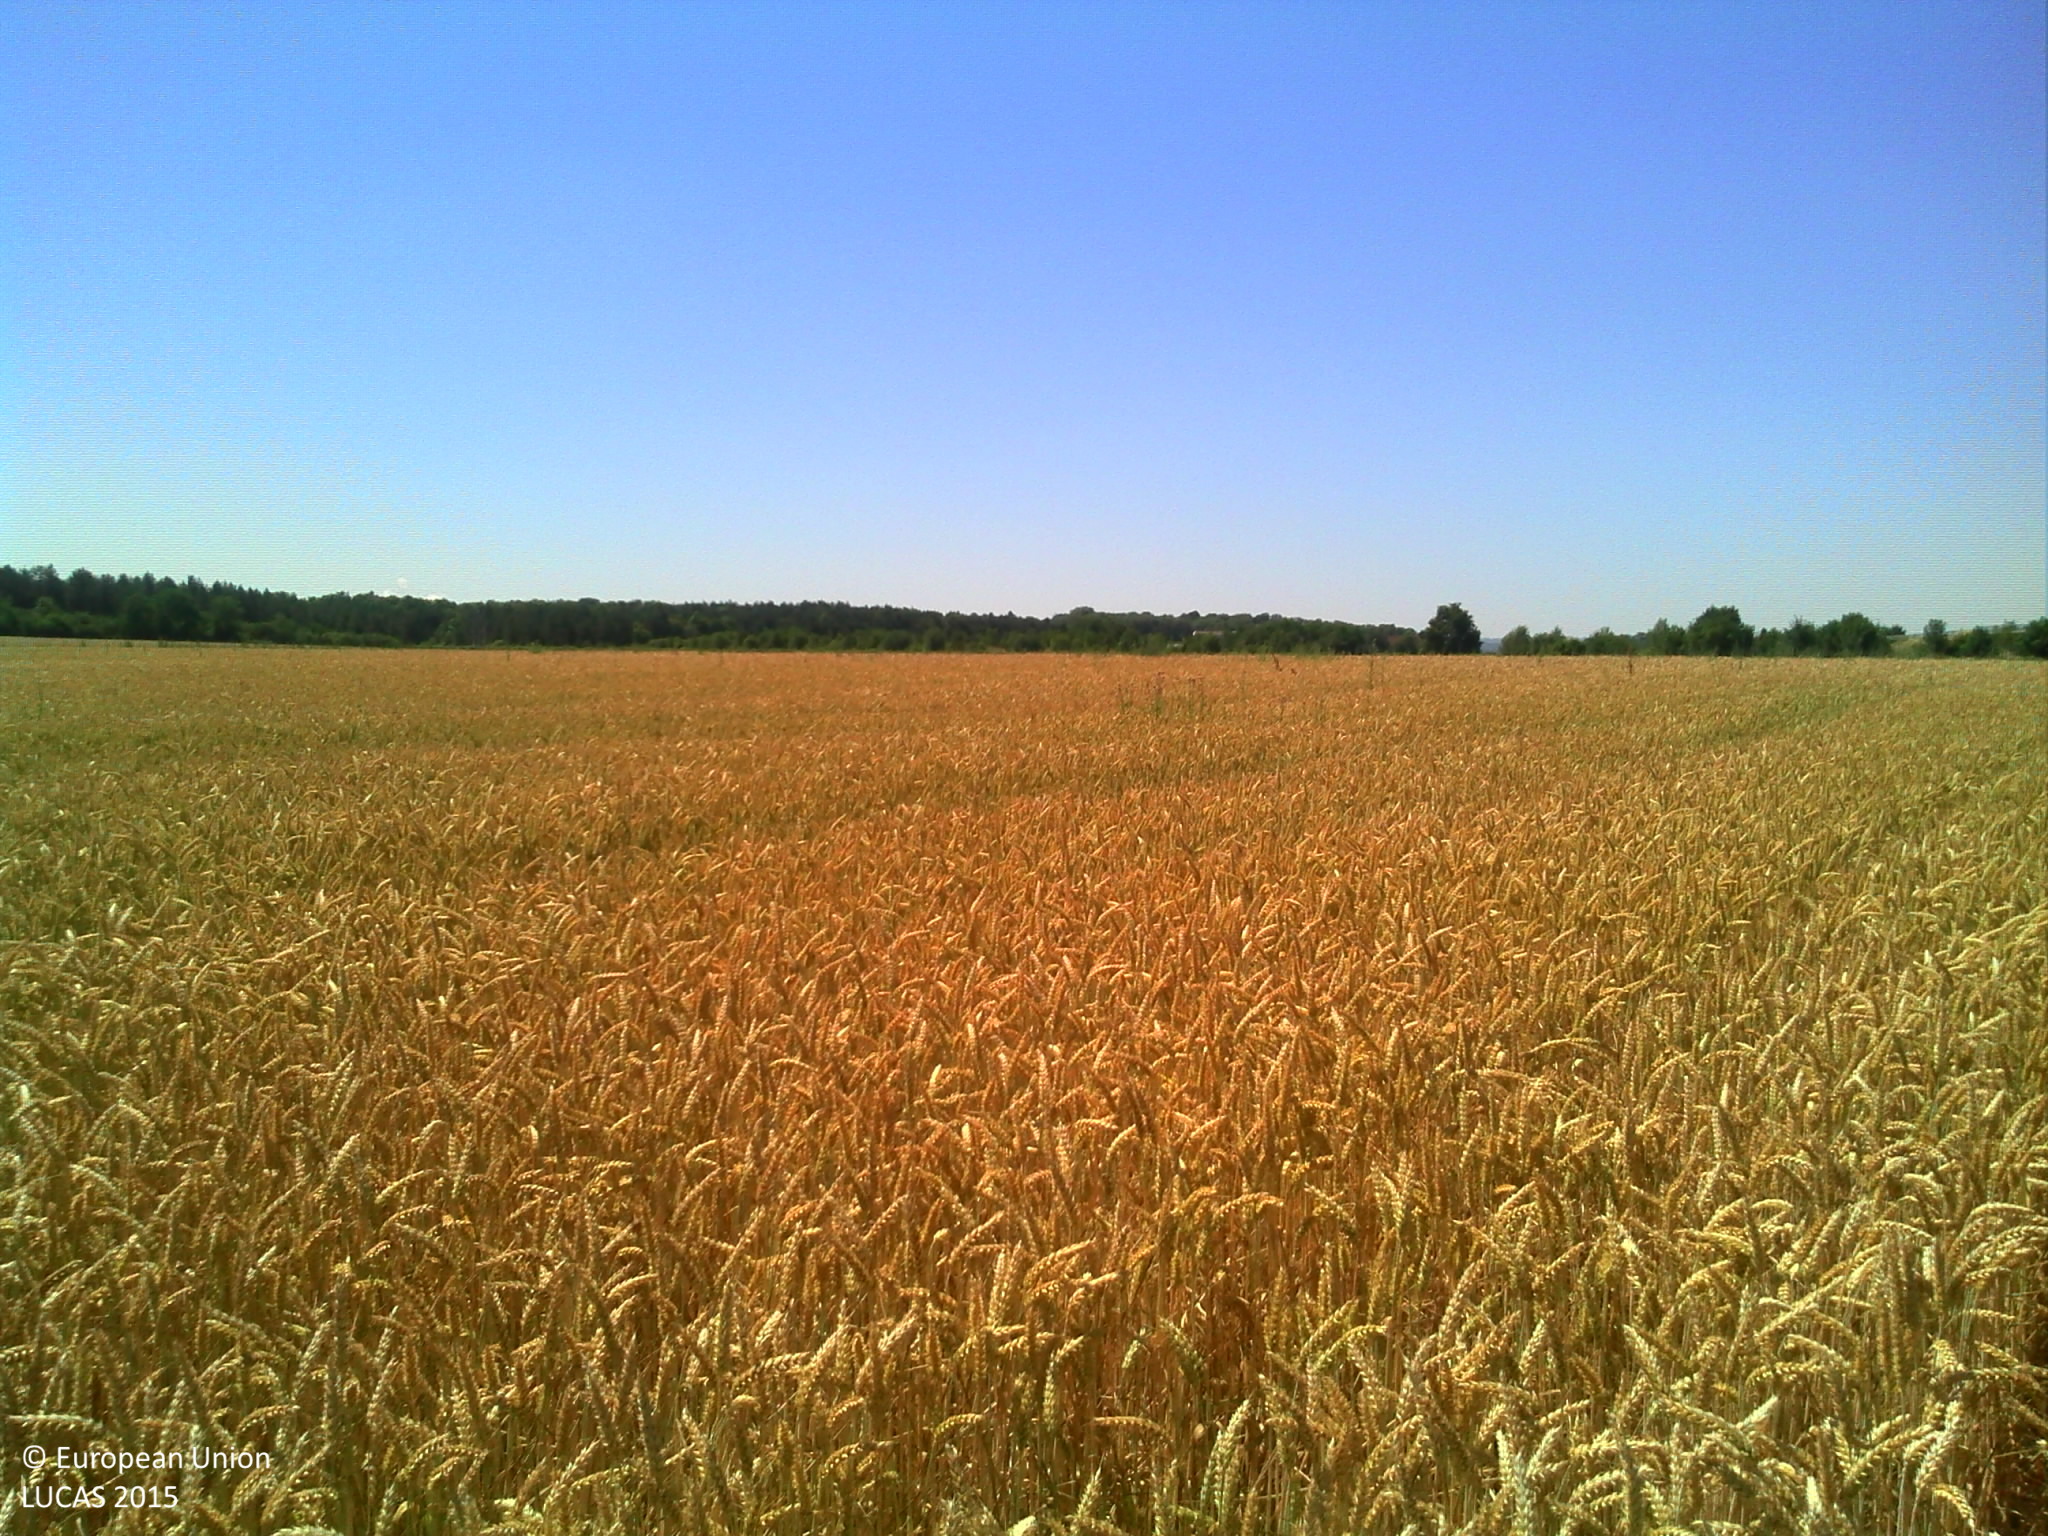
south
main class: Cropland
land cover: Common wheat
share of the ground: > 75 %
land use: Agriculture (excluding fallow land and kitchen gardens)
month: June
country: FR
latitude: 47.5939
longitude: 2.8519
